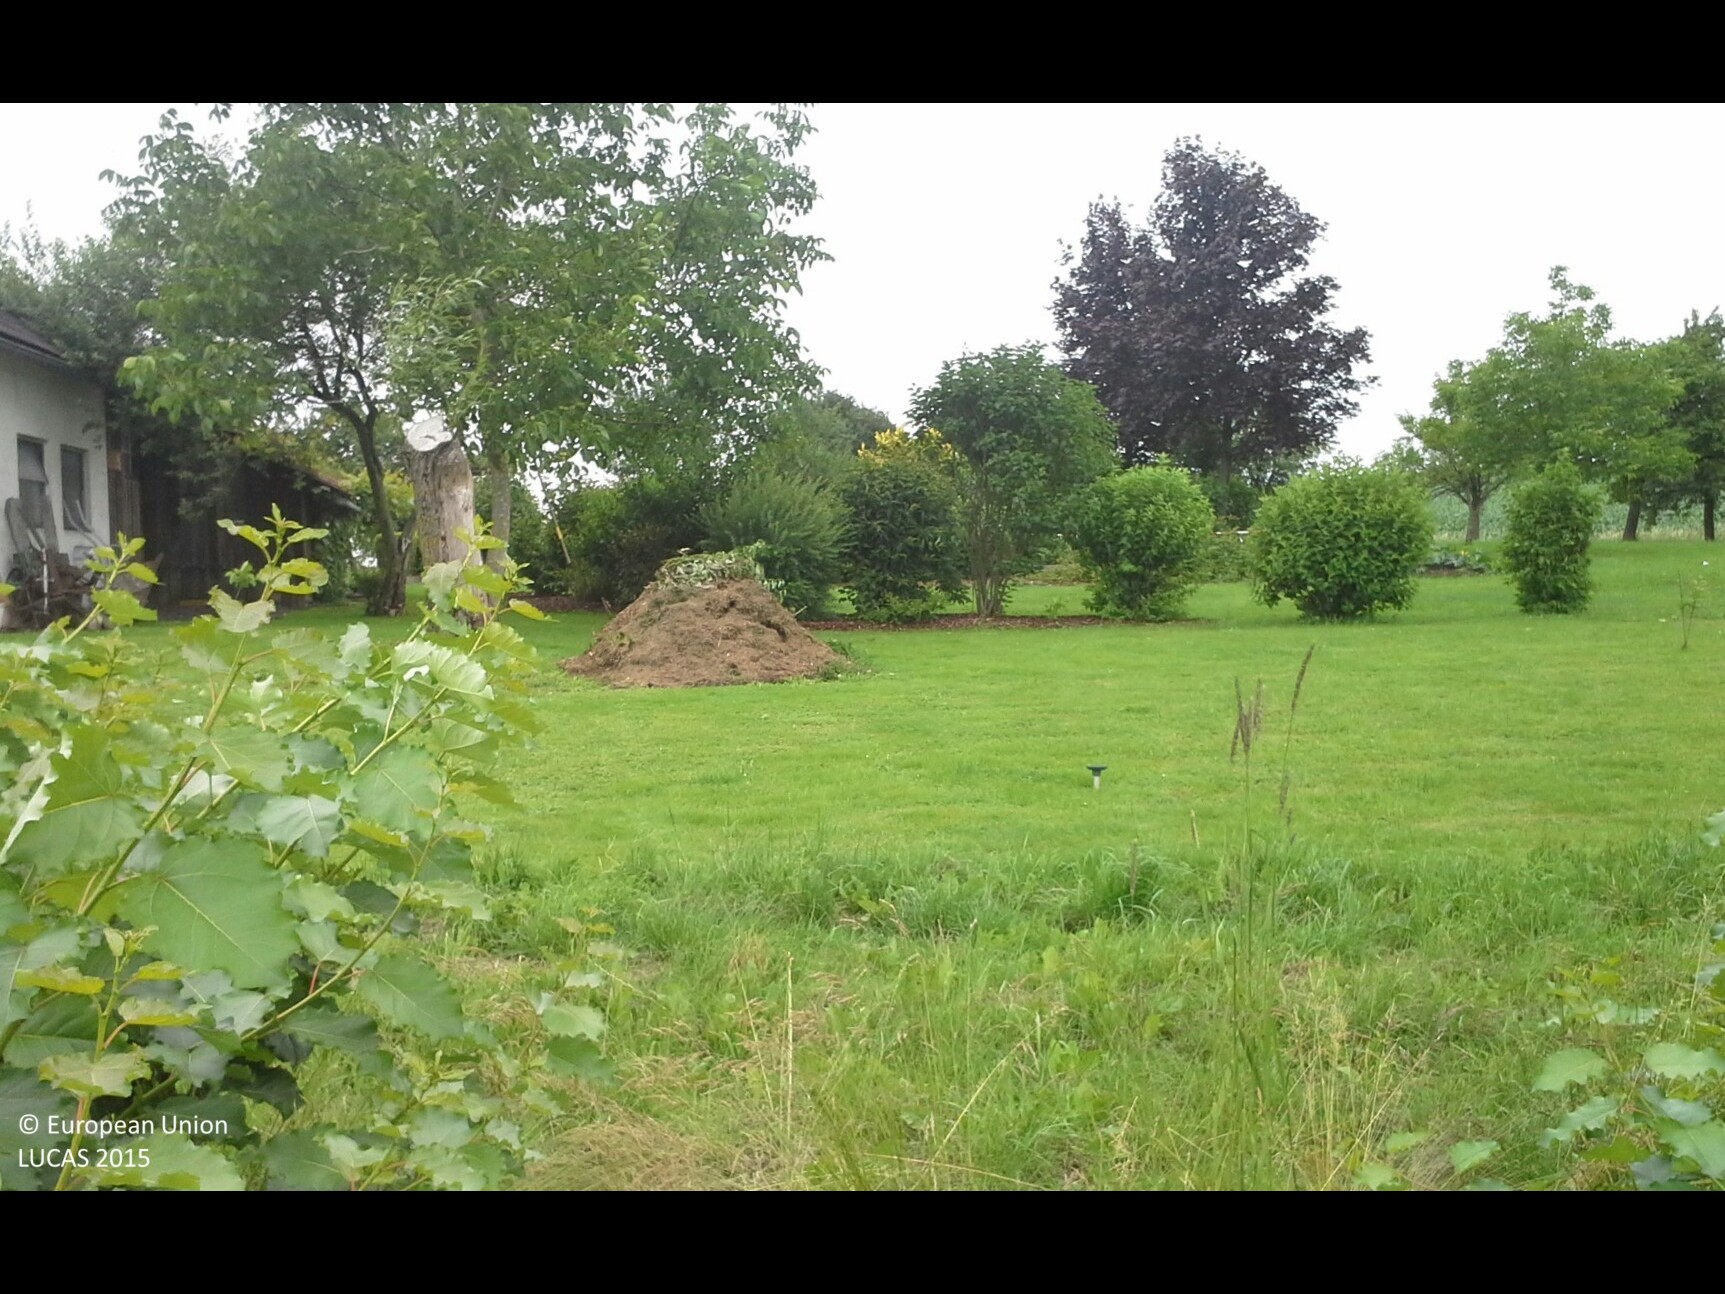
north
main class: Cropland
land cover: Other fruit trees and berries
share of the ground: 50 - 75 %
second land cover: Spontaneously vegetated surfaces
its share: 25 - 50 %
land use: Agriculture (excluding fallow land and kitchen gardens)
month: June
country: AT
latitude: 48.1093
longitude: 14.6071
